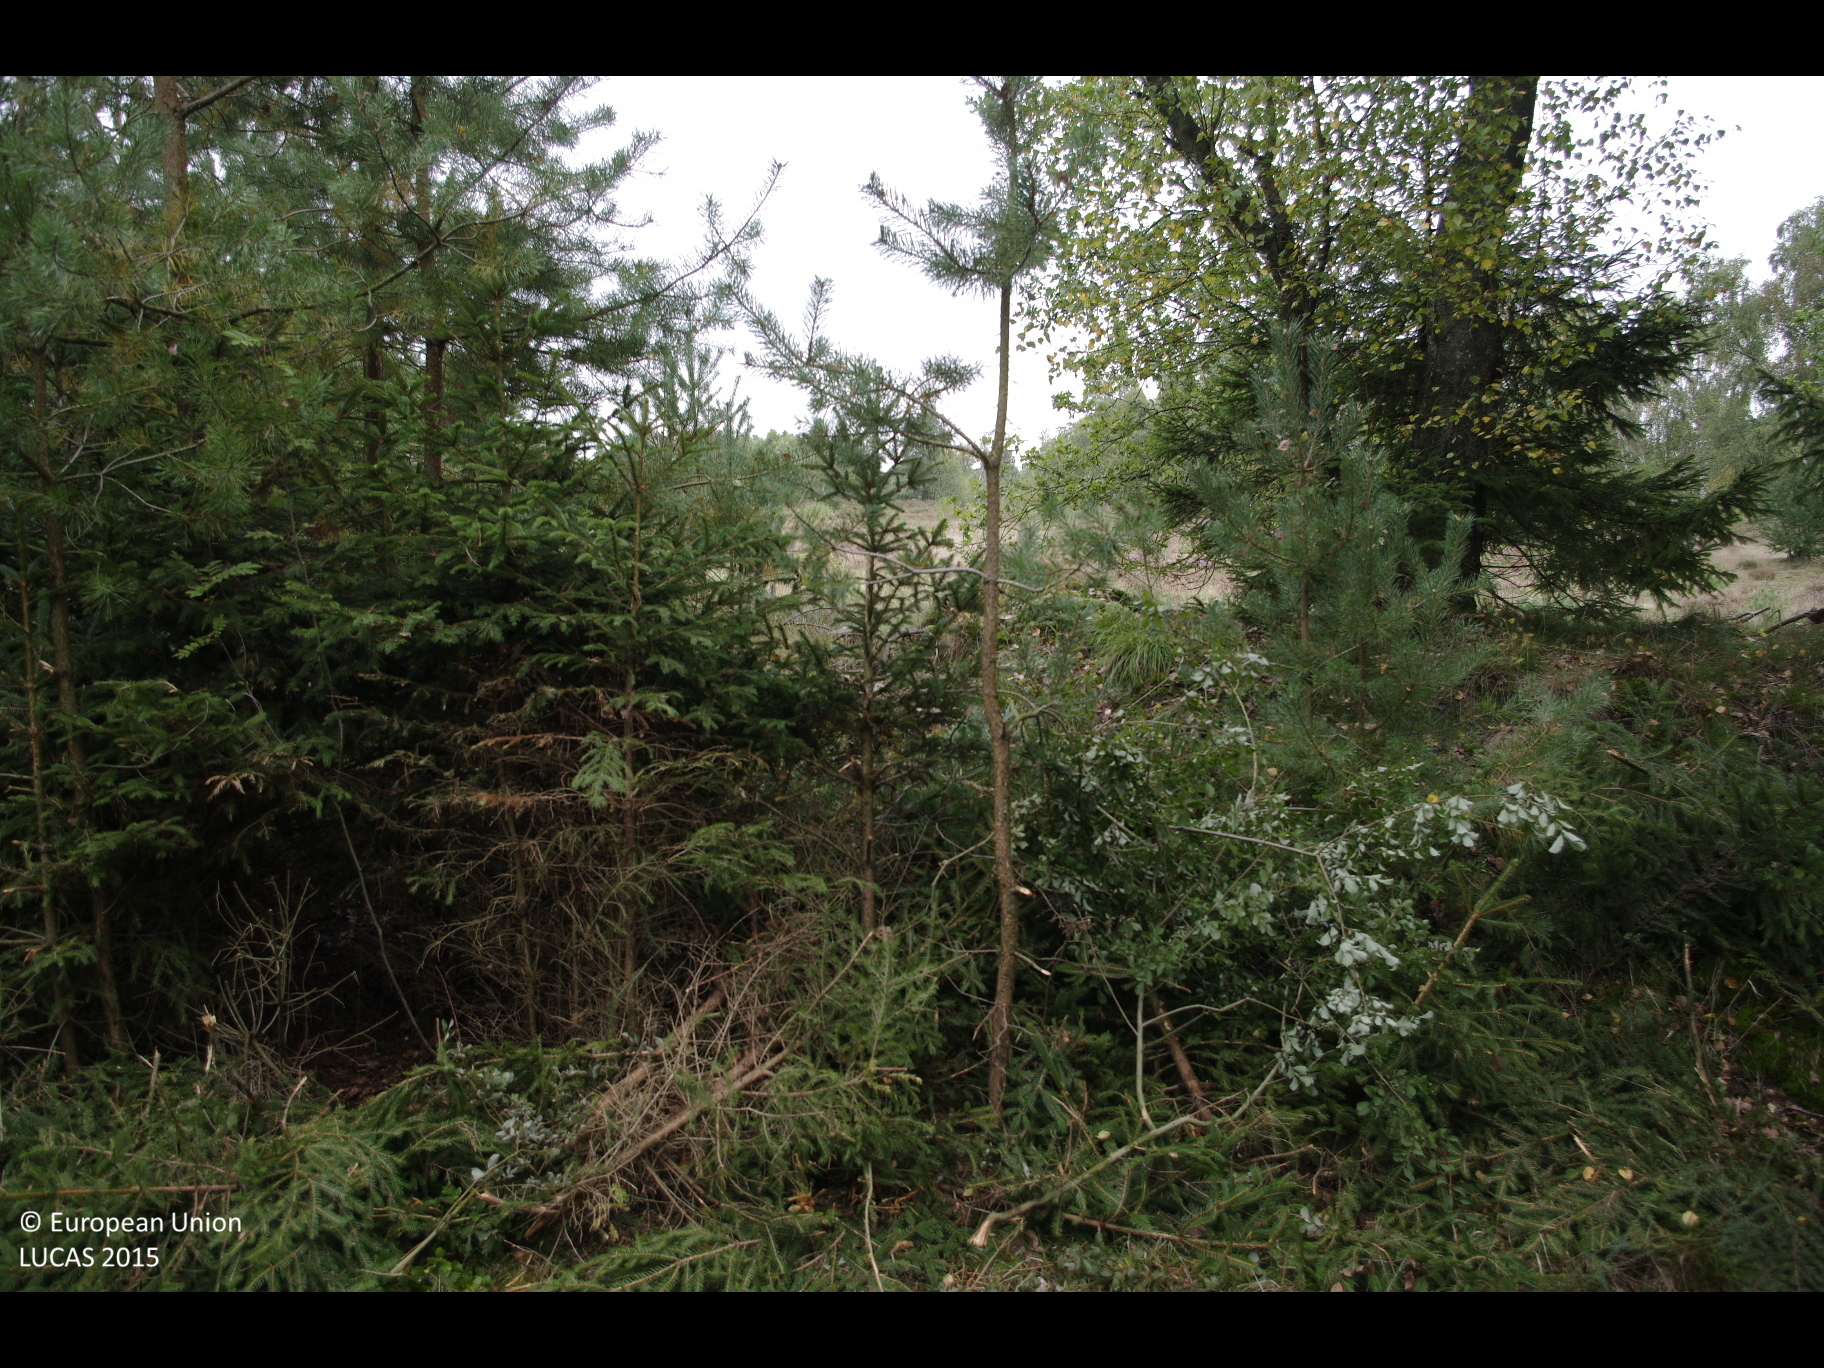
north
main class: Woodland
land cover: Pine dominated mixed woodland
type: hemiboreal forest and nemoral coniferous forest and mixed broadleaved-coniferous forest
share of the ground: > 75 %
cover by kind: coniferous forest trees 50 %, broadleaved forest trees 30 %, herbaceous plants 20 %
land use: Forestry
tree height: > 5 m
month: September
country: DE
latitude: 53.0964
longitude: 9.9254
